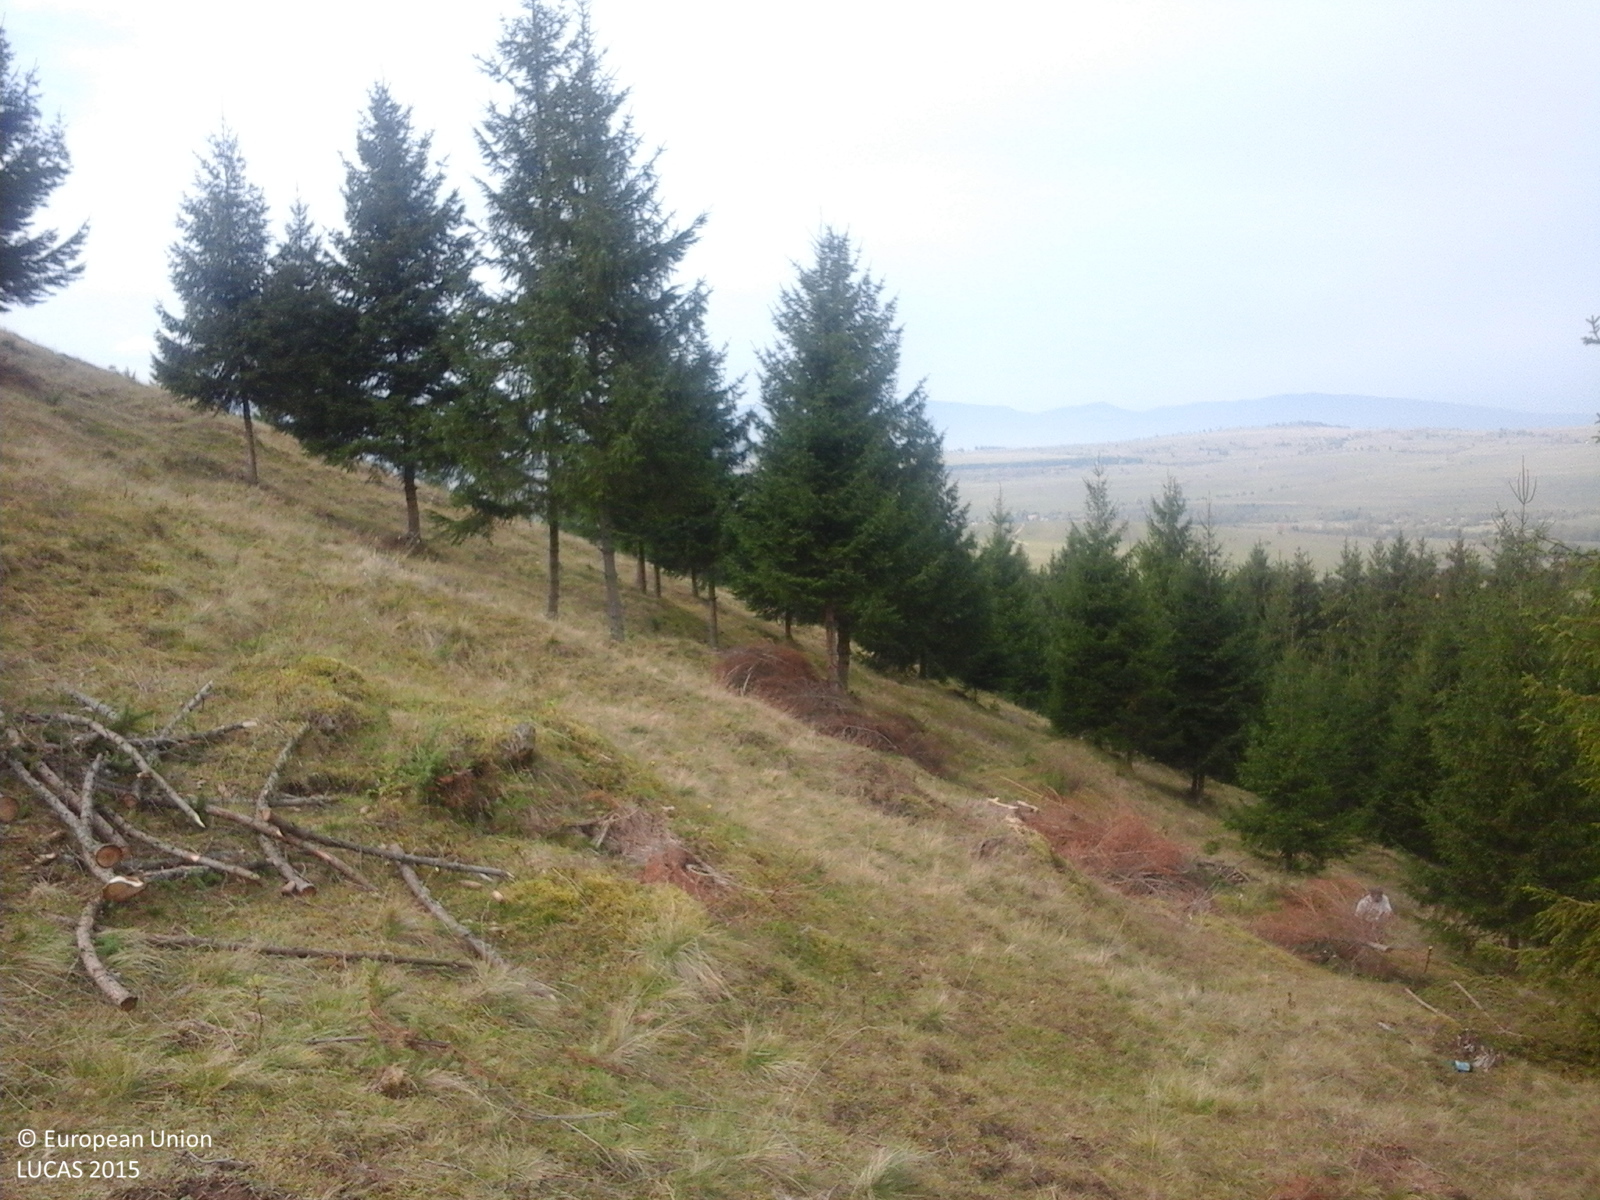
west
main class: Grassland
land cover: Grassland with sparse tree/shrub cover
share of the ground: > 75 %
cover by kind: herbaceous plants 85 %, shrubs 10 %, broadleaved forest trees 5 %
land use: Fallow land
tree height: > 5 m
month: October
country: RO
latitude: 46.4957
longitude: 25.8701
